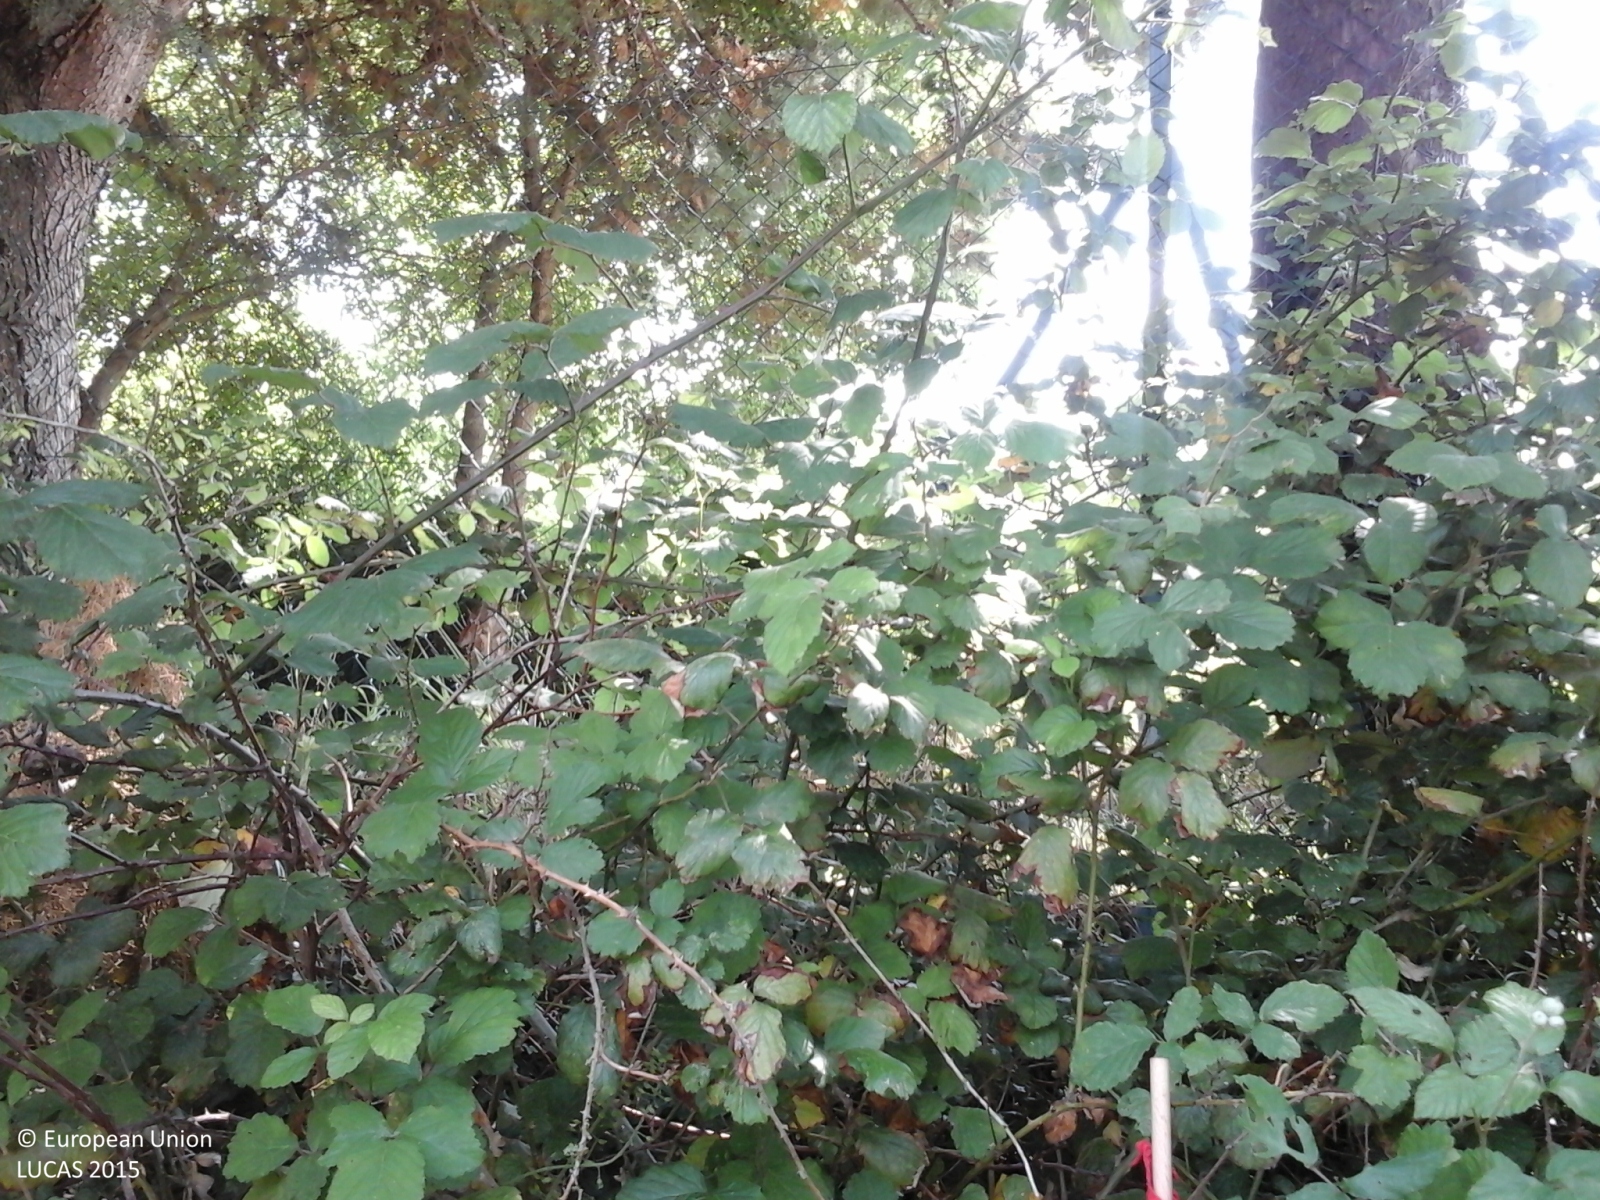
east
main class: Shrubland
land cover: Shrubland with sparse tree cover
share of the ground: > 75 %
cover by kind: shrubs 85 %, herbaceous plants 10 %, broadleaved forest trees 5 %
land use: Semi-natural and natural areas not in use
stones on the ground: < 10 %
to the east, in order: Shrubland with sparse tree cover; Fences; Lines of trees; Tracks; Shrubland with sparse tree cover; Olive groves; Electric lines; Olive groves; Broadleaved woodland; Fences; Arable land (only in case pi); Permanent crops (only in case pi); Lines of trees; Fences; Grassland without tree/shrub cover; Electric lines; Grassland with sparse tree/shrub cover; Fences
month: June
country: IT
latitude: 43.8334
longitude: 11.5754
